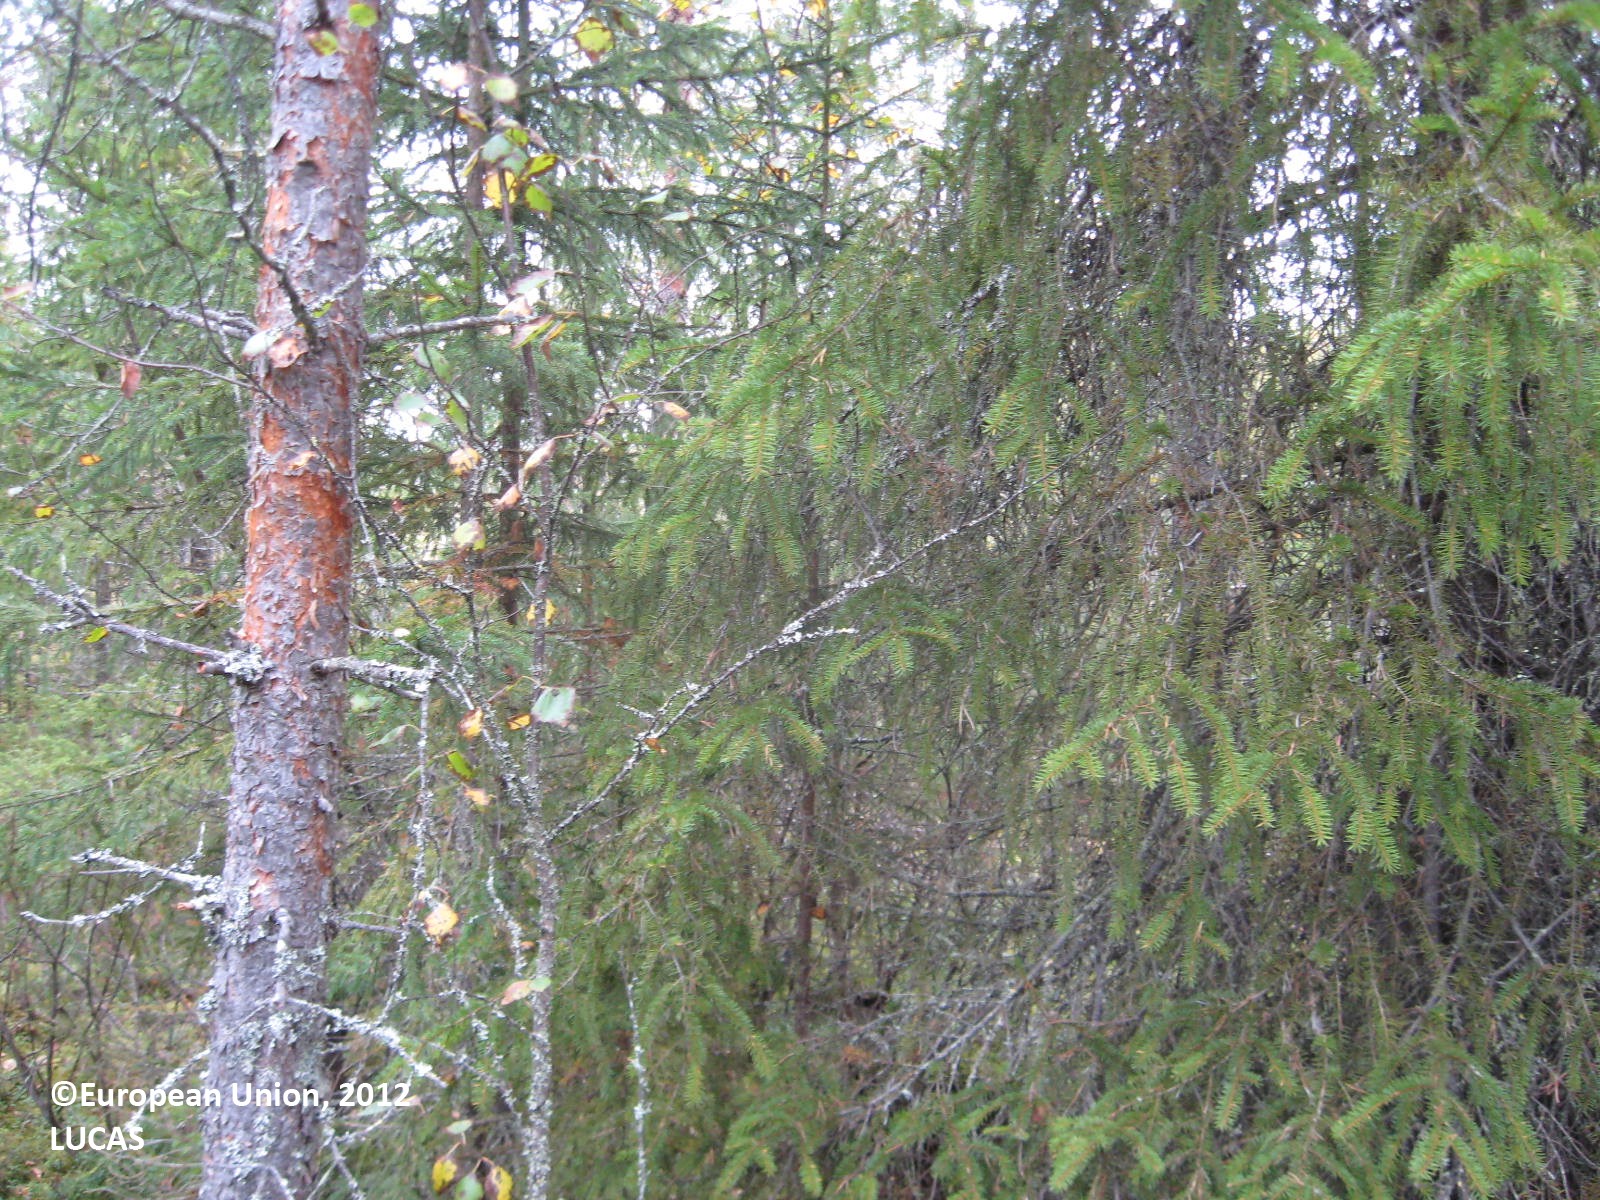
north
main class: Woodland
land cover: Pine dominated coniferous woodland
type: boreal forest
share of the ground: > 75 %
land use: Forestry
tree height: > 5 m
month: September
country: FI
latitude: 64.0196
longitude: 28.3670
